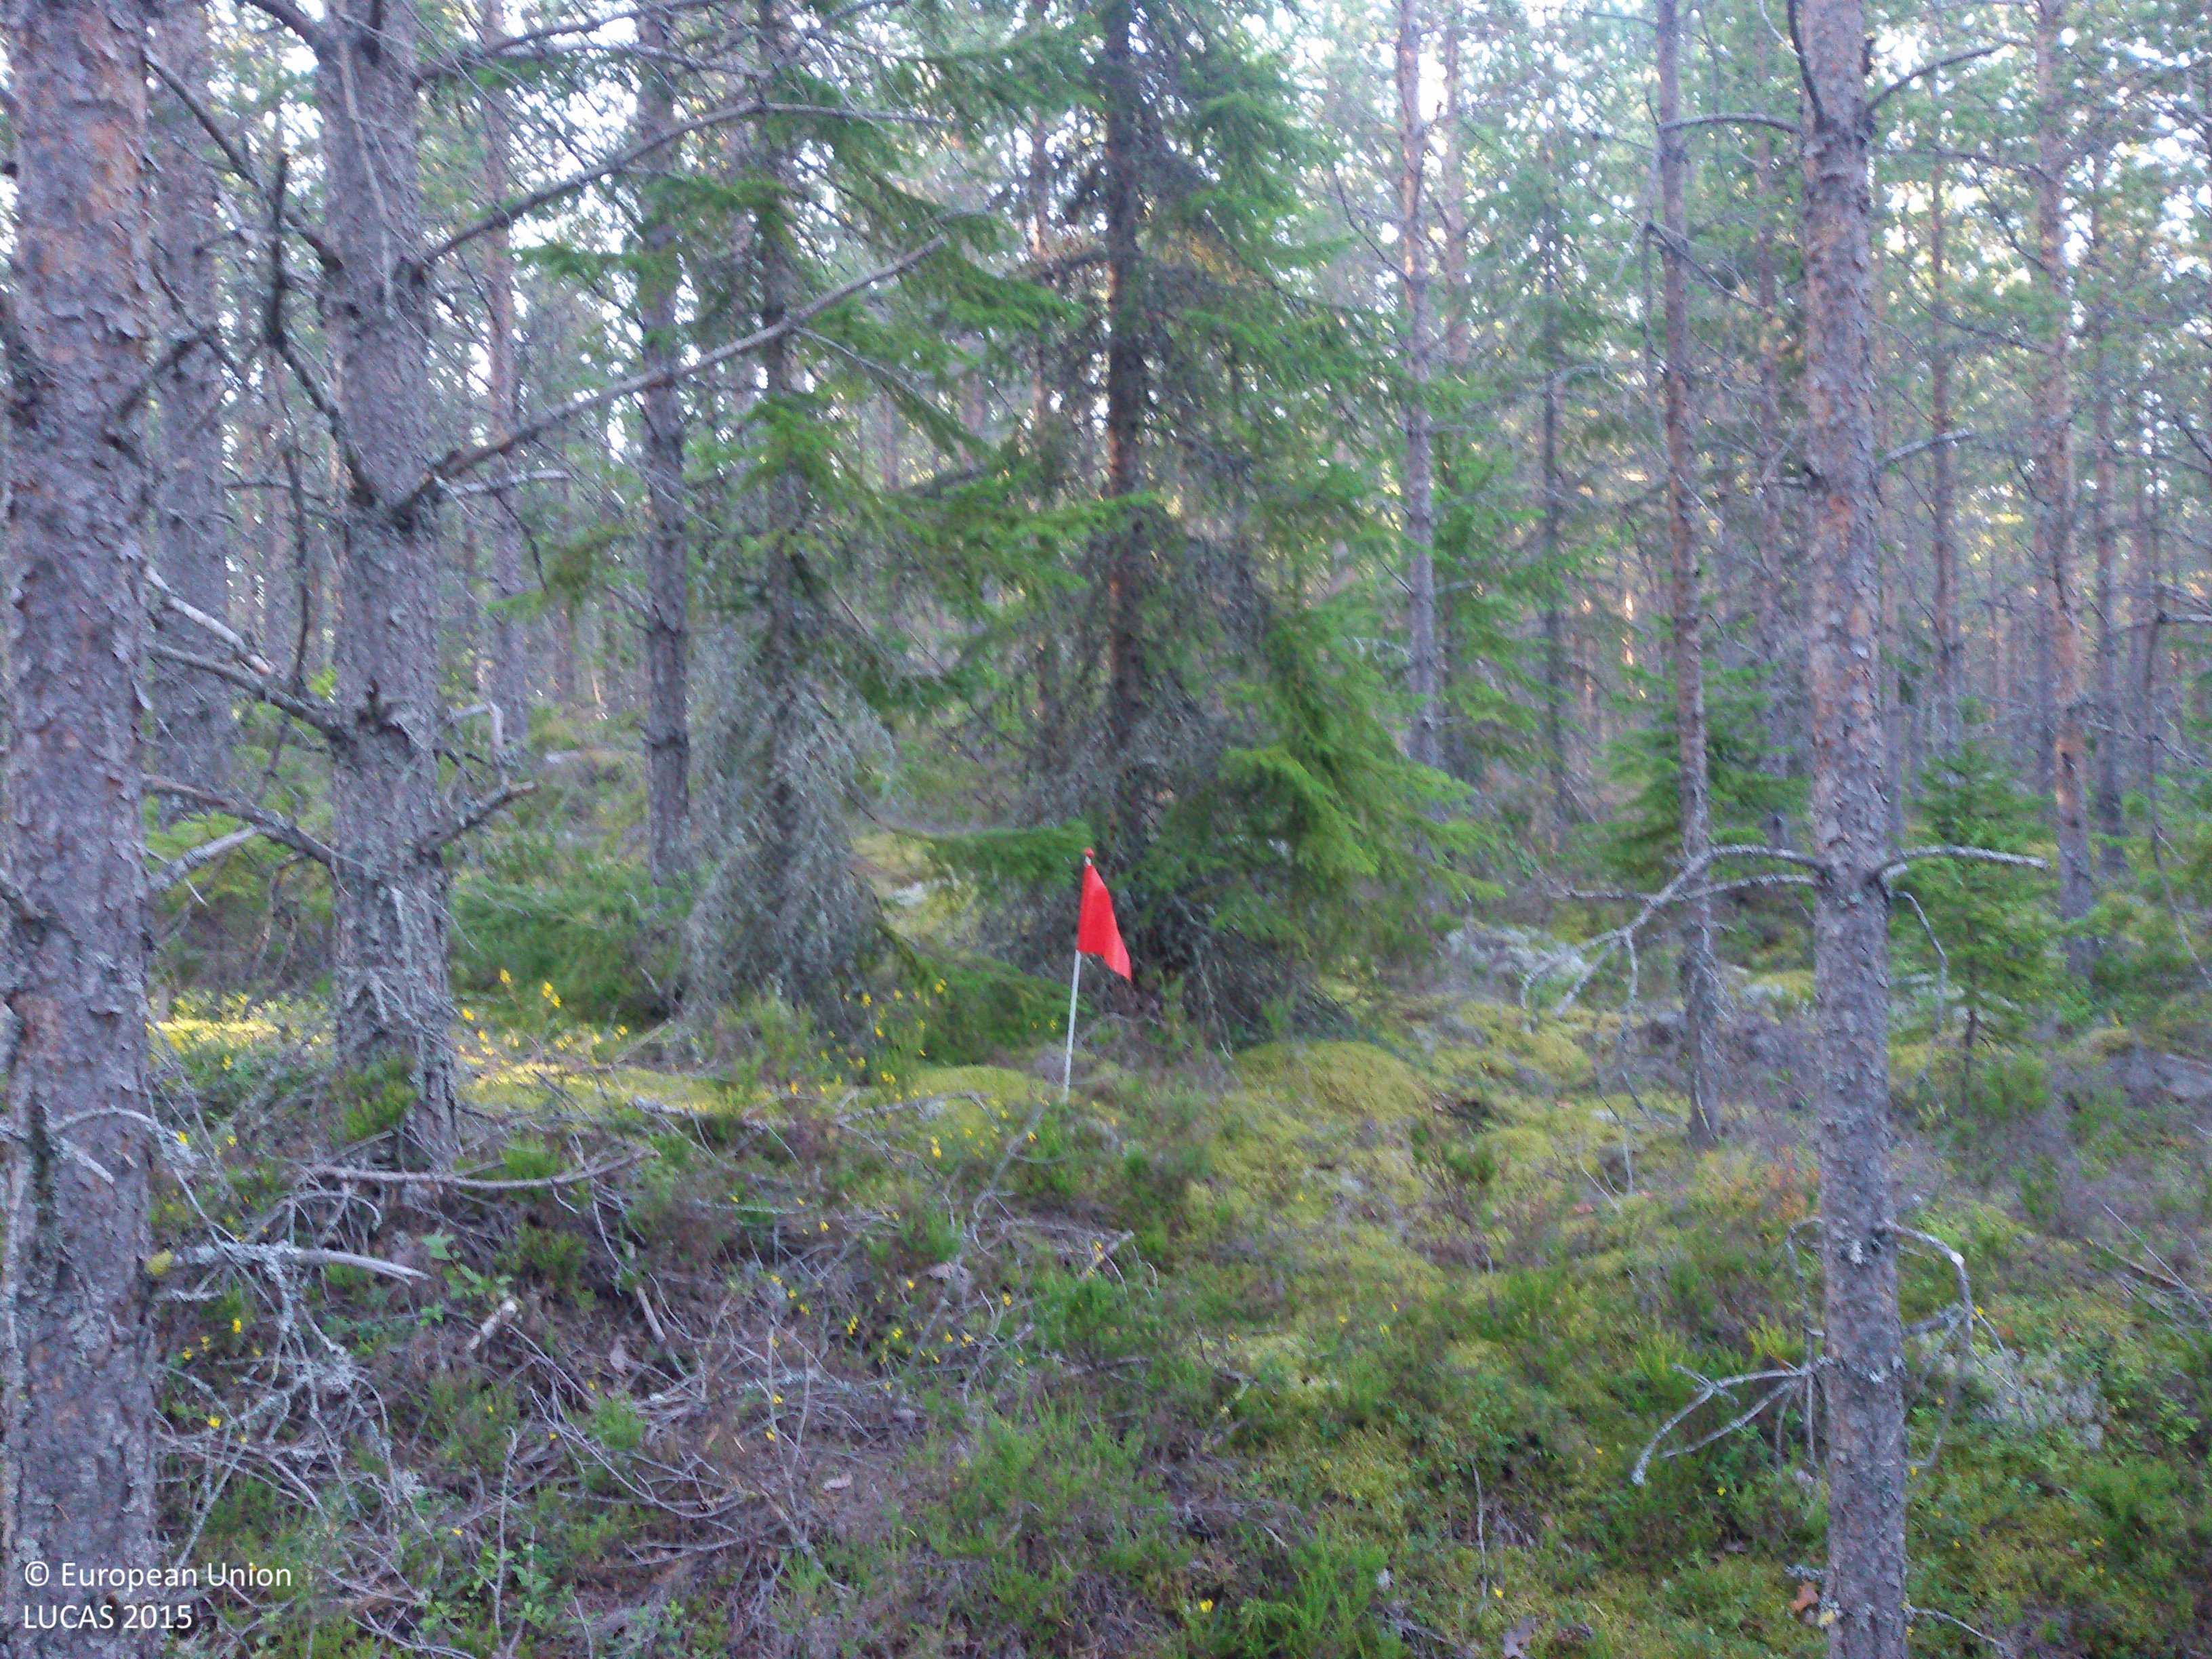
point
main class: Woodland
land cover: Pine dominated coniferous woodland
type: boreal forest
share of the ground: > 75 %
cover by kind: coniferous forest trees 90 %, shrubs 5 %, lichens and mosses 5 %
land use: Forestry
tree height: > 5 m
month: August
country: SE
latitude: 60.8791
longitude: 16.5264
